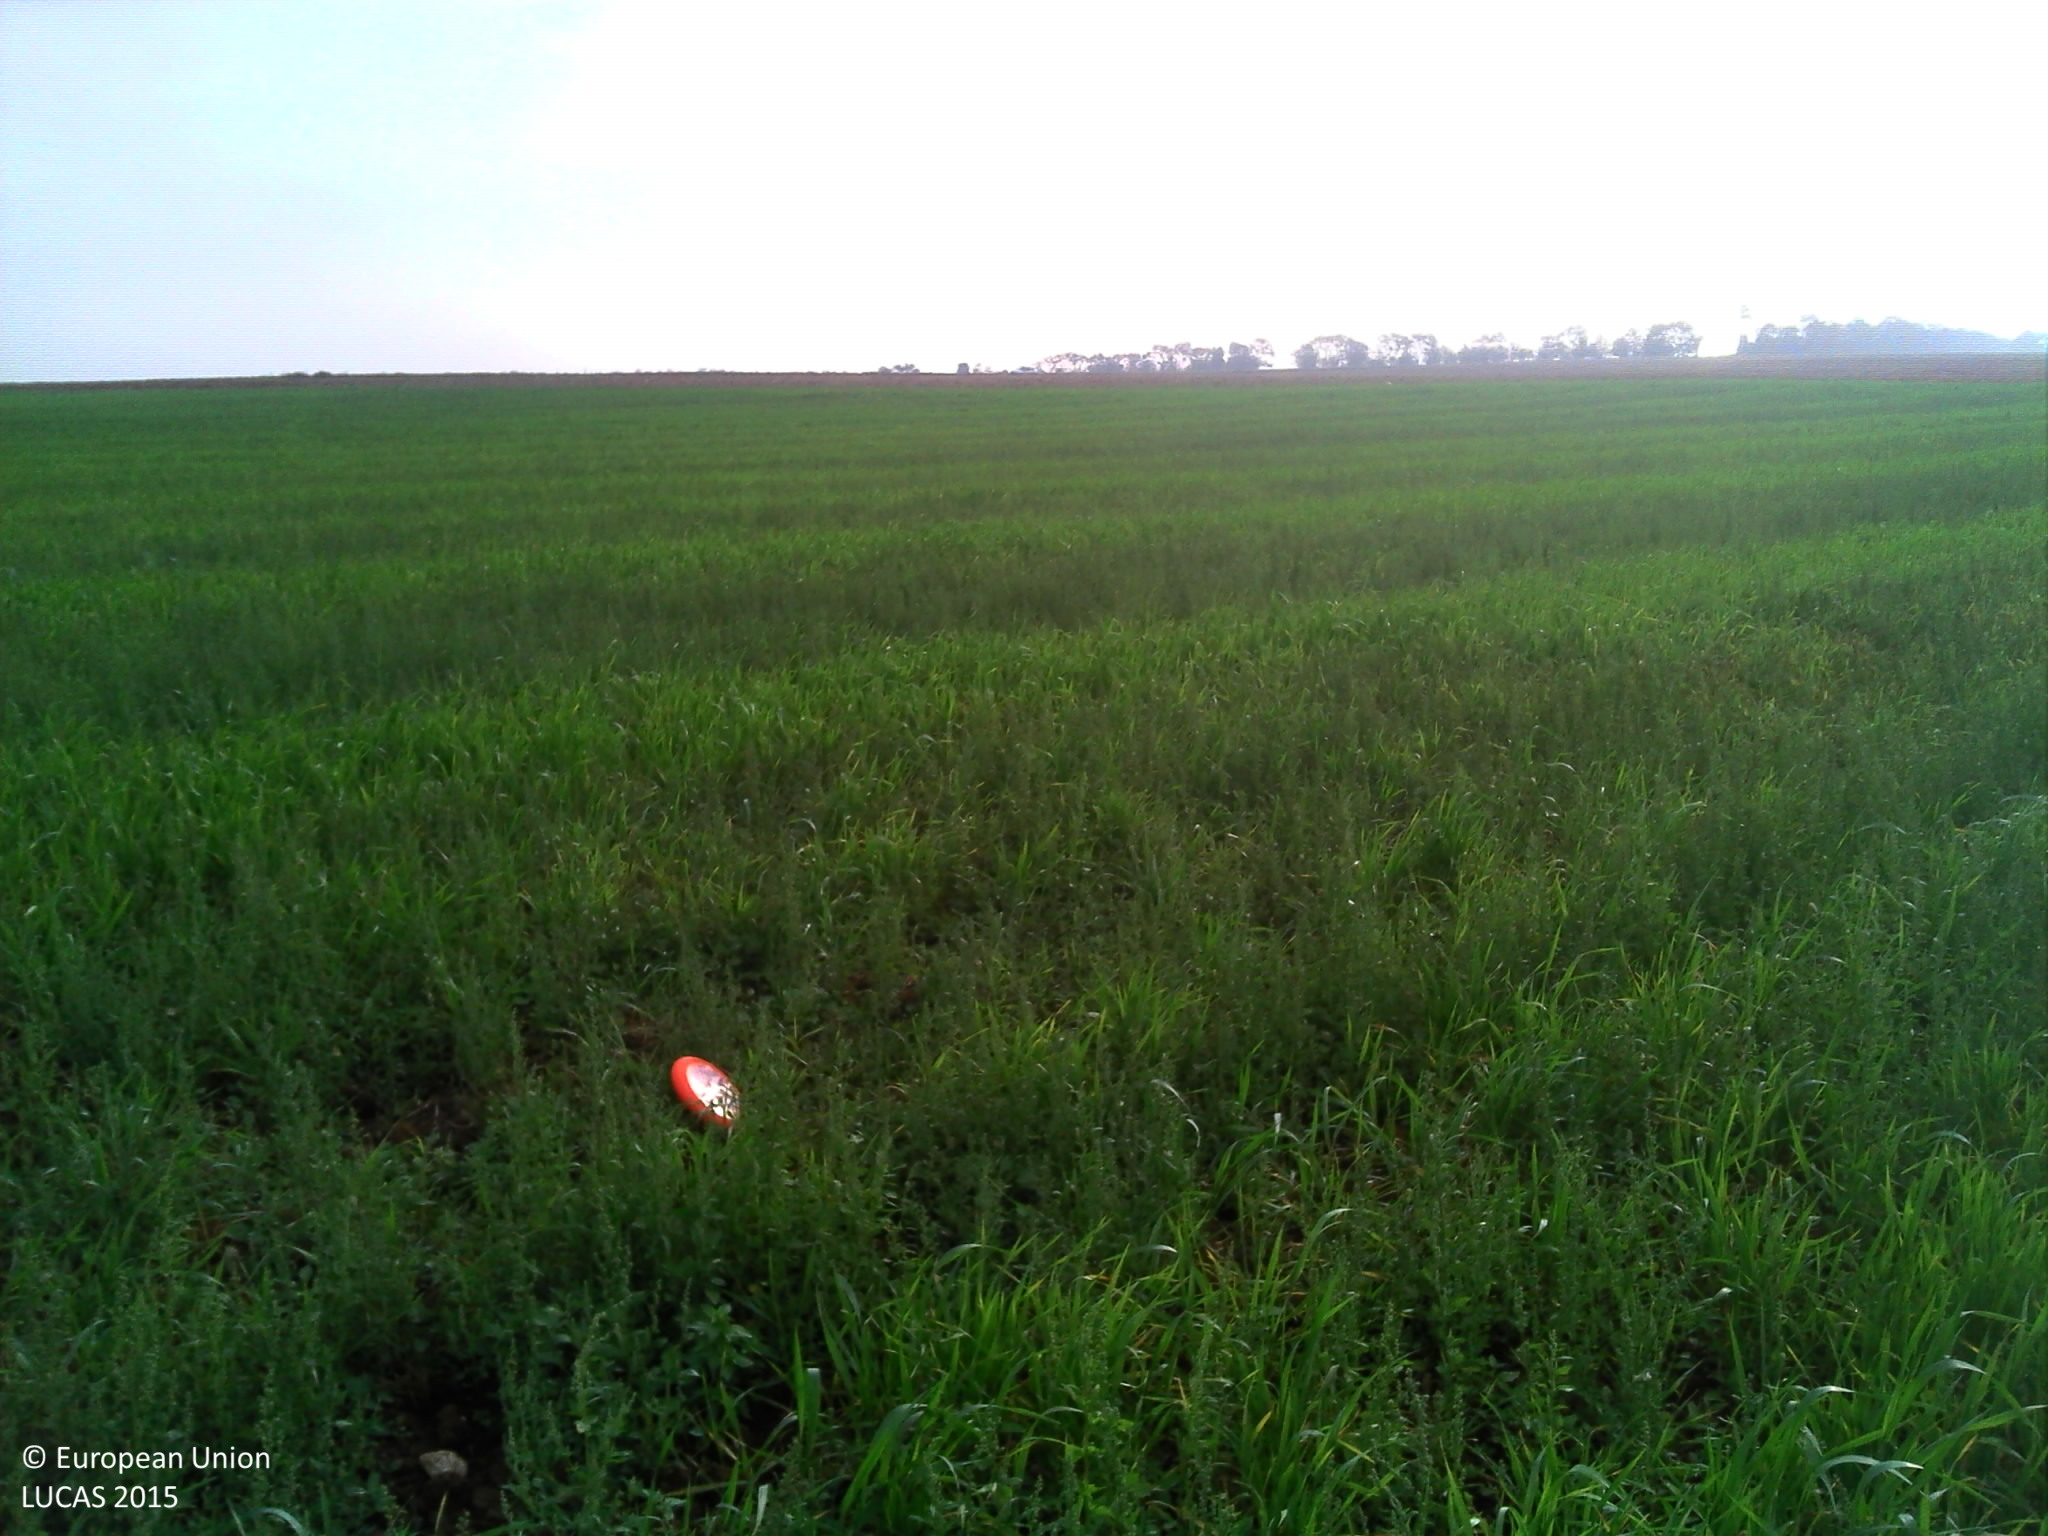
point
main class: Cropland
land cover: Common wheat
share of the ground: 25 - 50 %
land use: Agriculture (excluding fallow land and kitchen gardens)
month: October
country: FR
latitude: 46.4892
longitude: -1.0143
